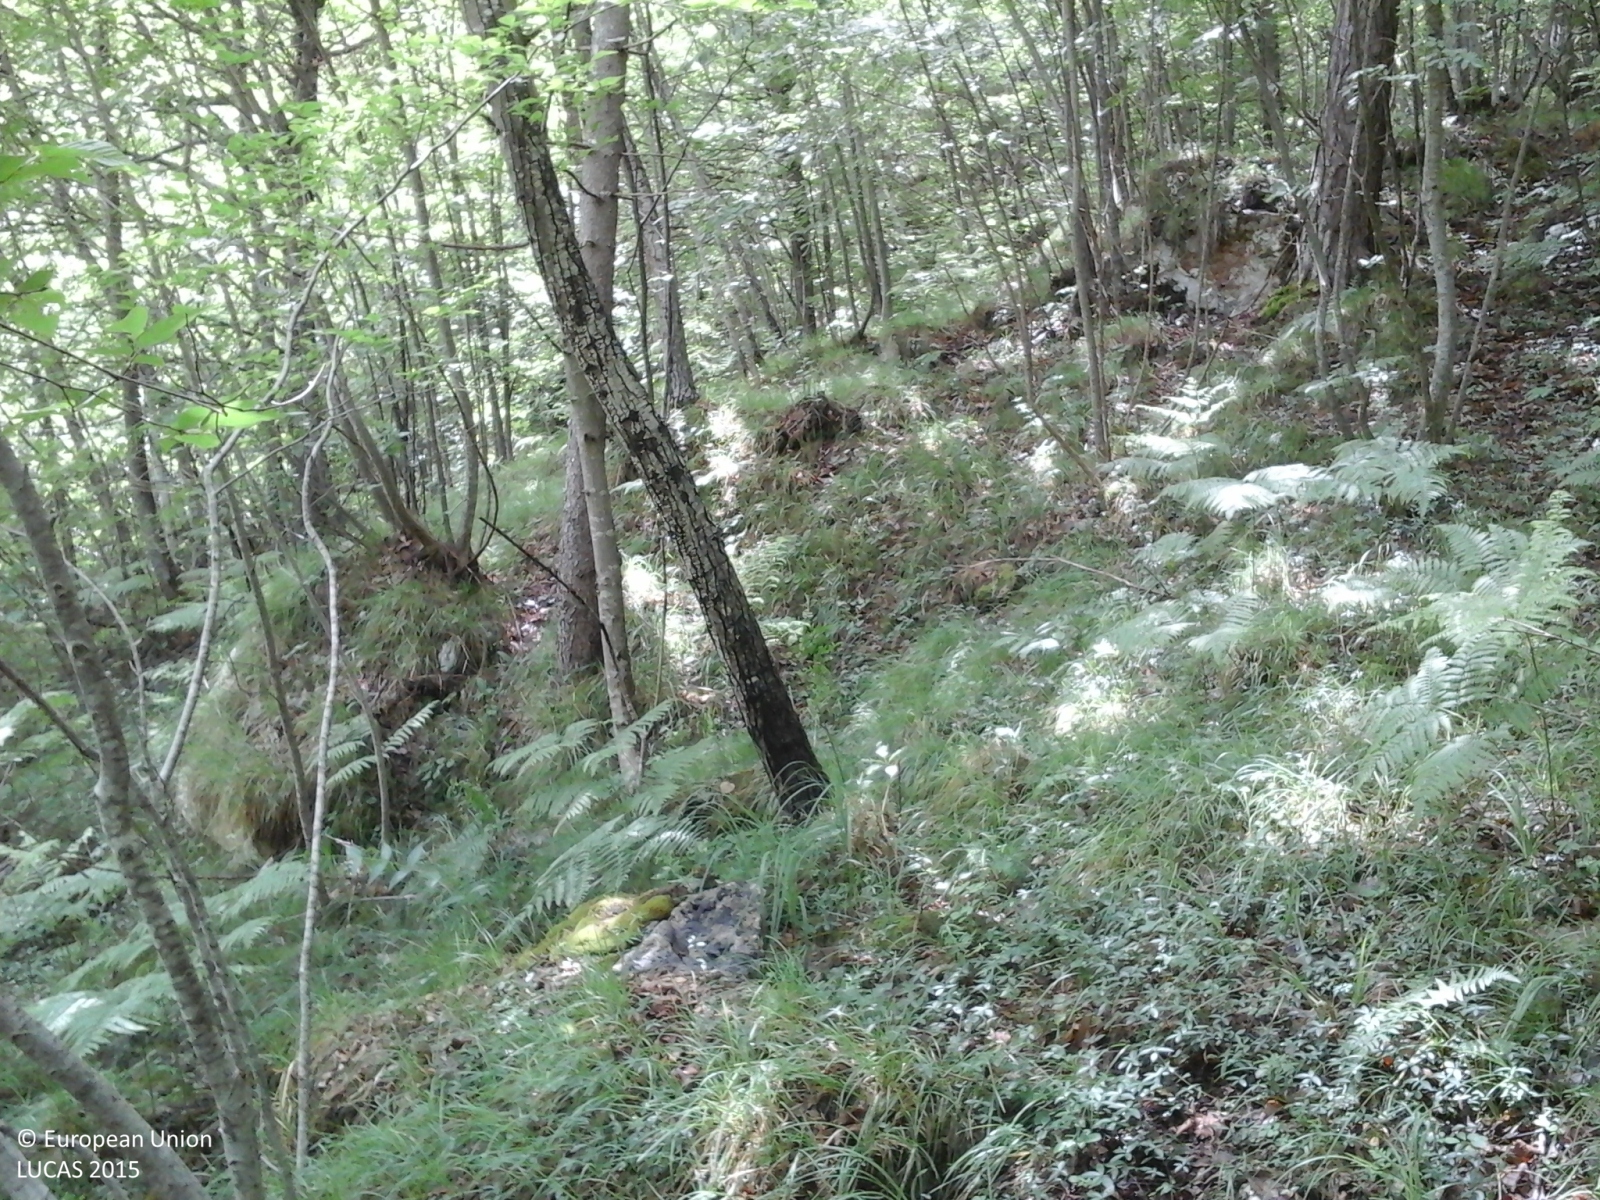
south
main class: Woodland
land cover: Broadleaved woodland
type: thermophilous deciduous forest
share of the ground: > 75 %
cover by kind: broadleaved forest trees 95 %, coniferous forest trees 5 %
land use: Forestry
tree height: > 5 m
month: June
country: IT
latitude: 46.0151
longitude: 11.5864
